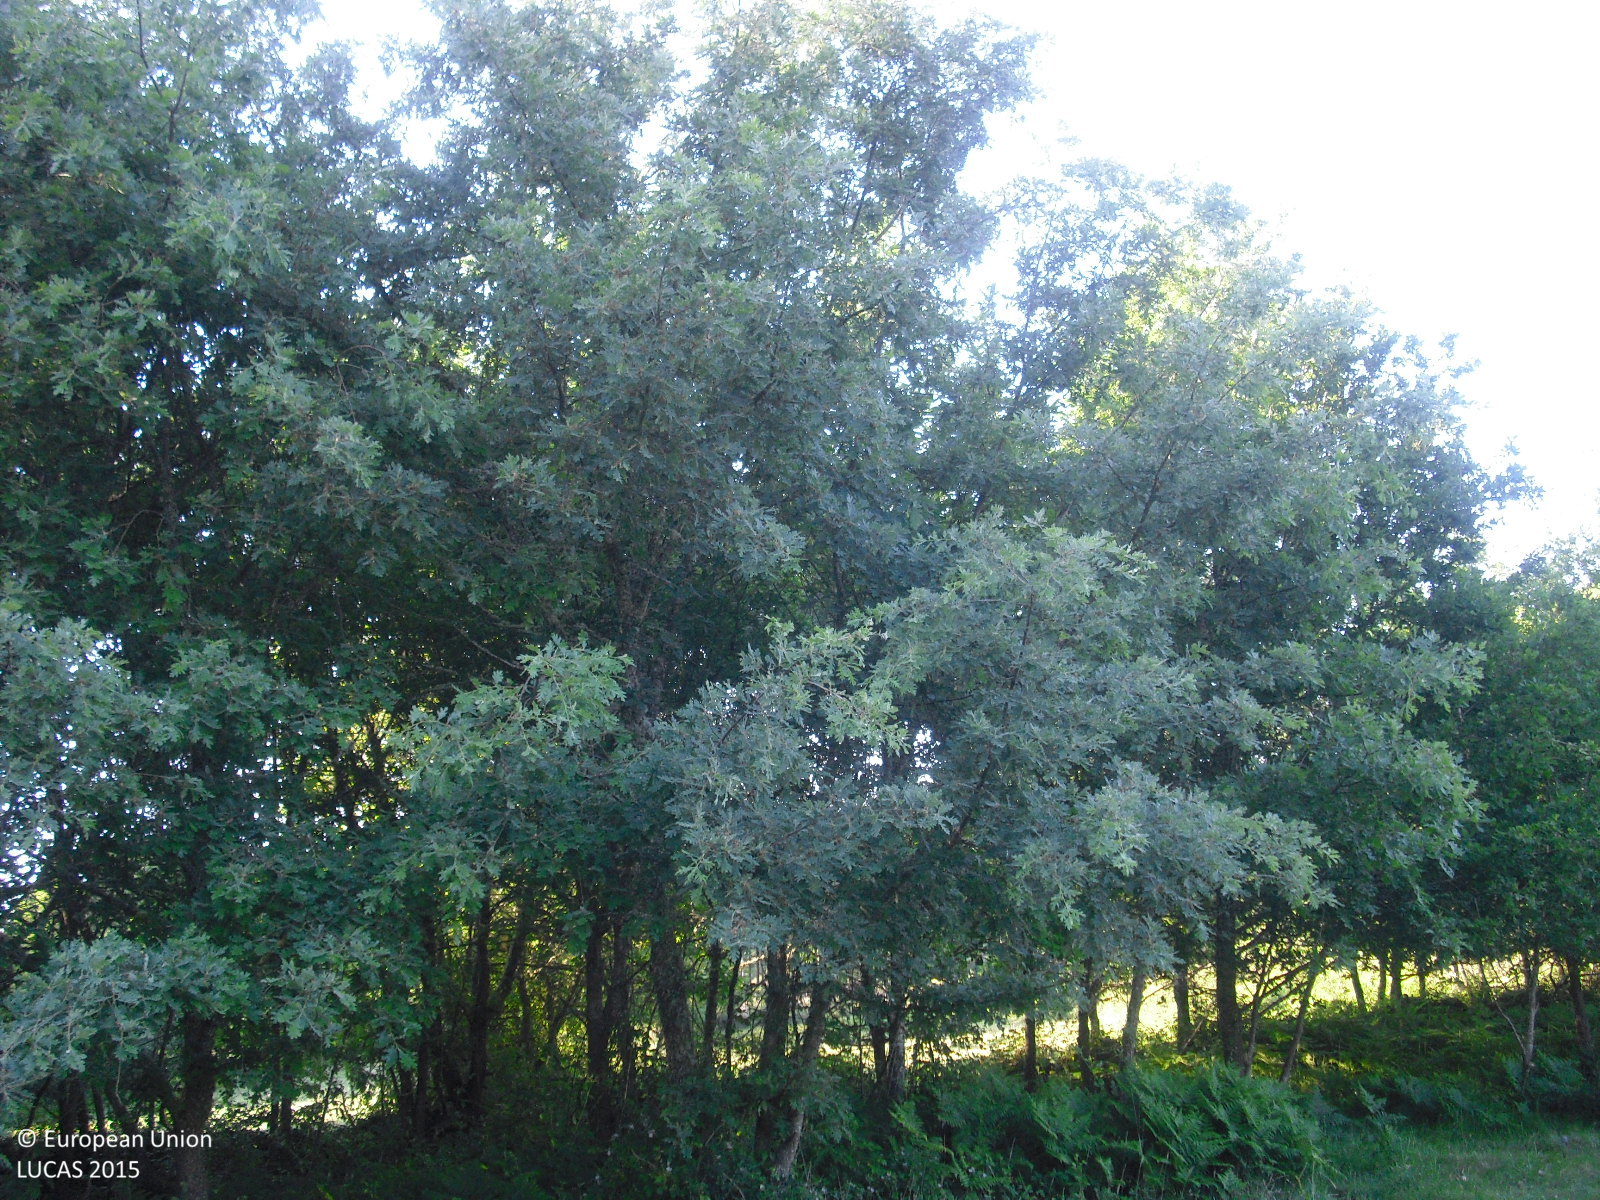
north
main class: Grassland
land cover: Grassland without tree/shrub cover
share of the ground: > 75 %
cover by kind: herbaceous plants 100 %
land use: Agriculture (excluding fallow land and kitchen gardens)
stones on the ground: < 10 %
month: May
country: ES
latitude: 42.2375
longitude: -7.7278
